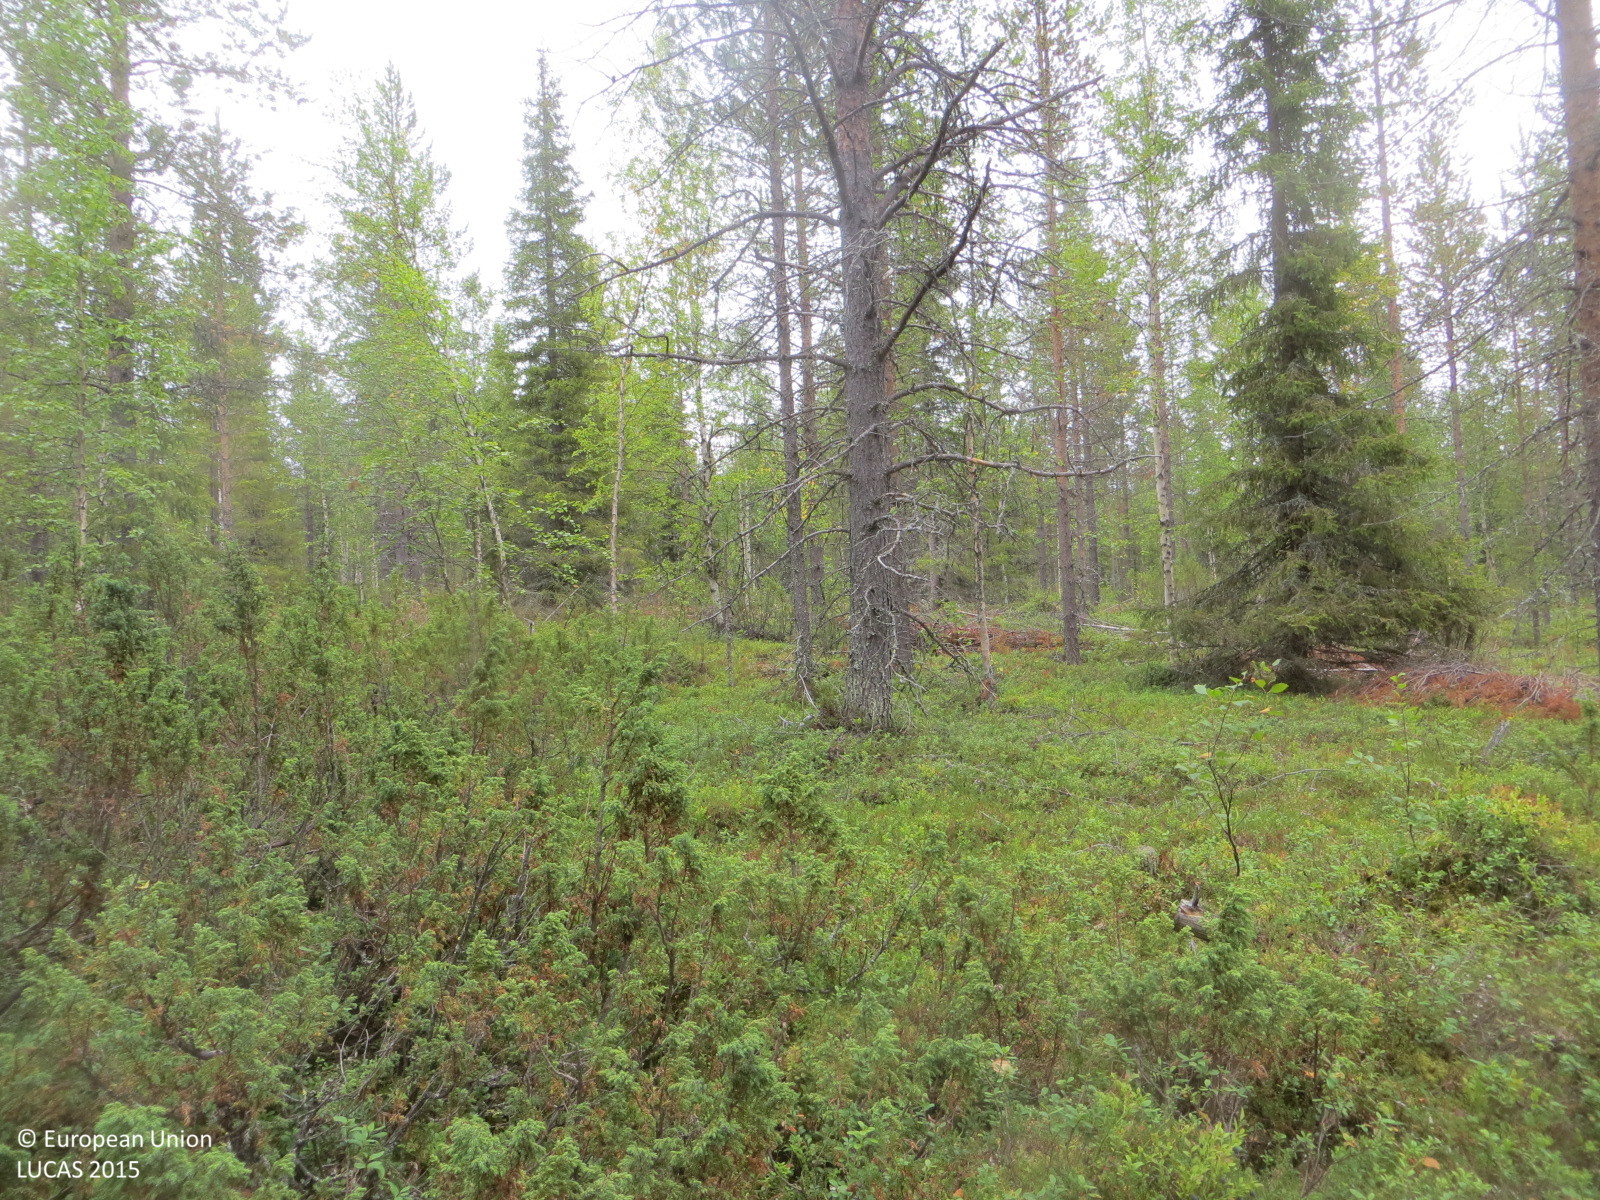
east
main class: Woodland
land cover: Pine dominated mixed woodland
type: boreal forest
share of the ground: 50 - 75 %
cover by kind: broadleaved forest trees 40 %, shrubs 40 %, coniferous forest trees 20 %
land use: Forestry
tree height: > 5 m
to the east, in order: Pine dominated mixed woodland; Ditches and canals; Pine dominated mixed woodland; Ditches and canals; Pine dominated mixed woodland; Ditches and canals; Other mixed woodland
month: August
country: FI
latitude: 67.9943
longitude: 25.1732
